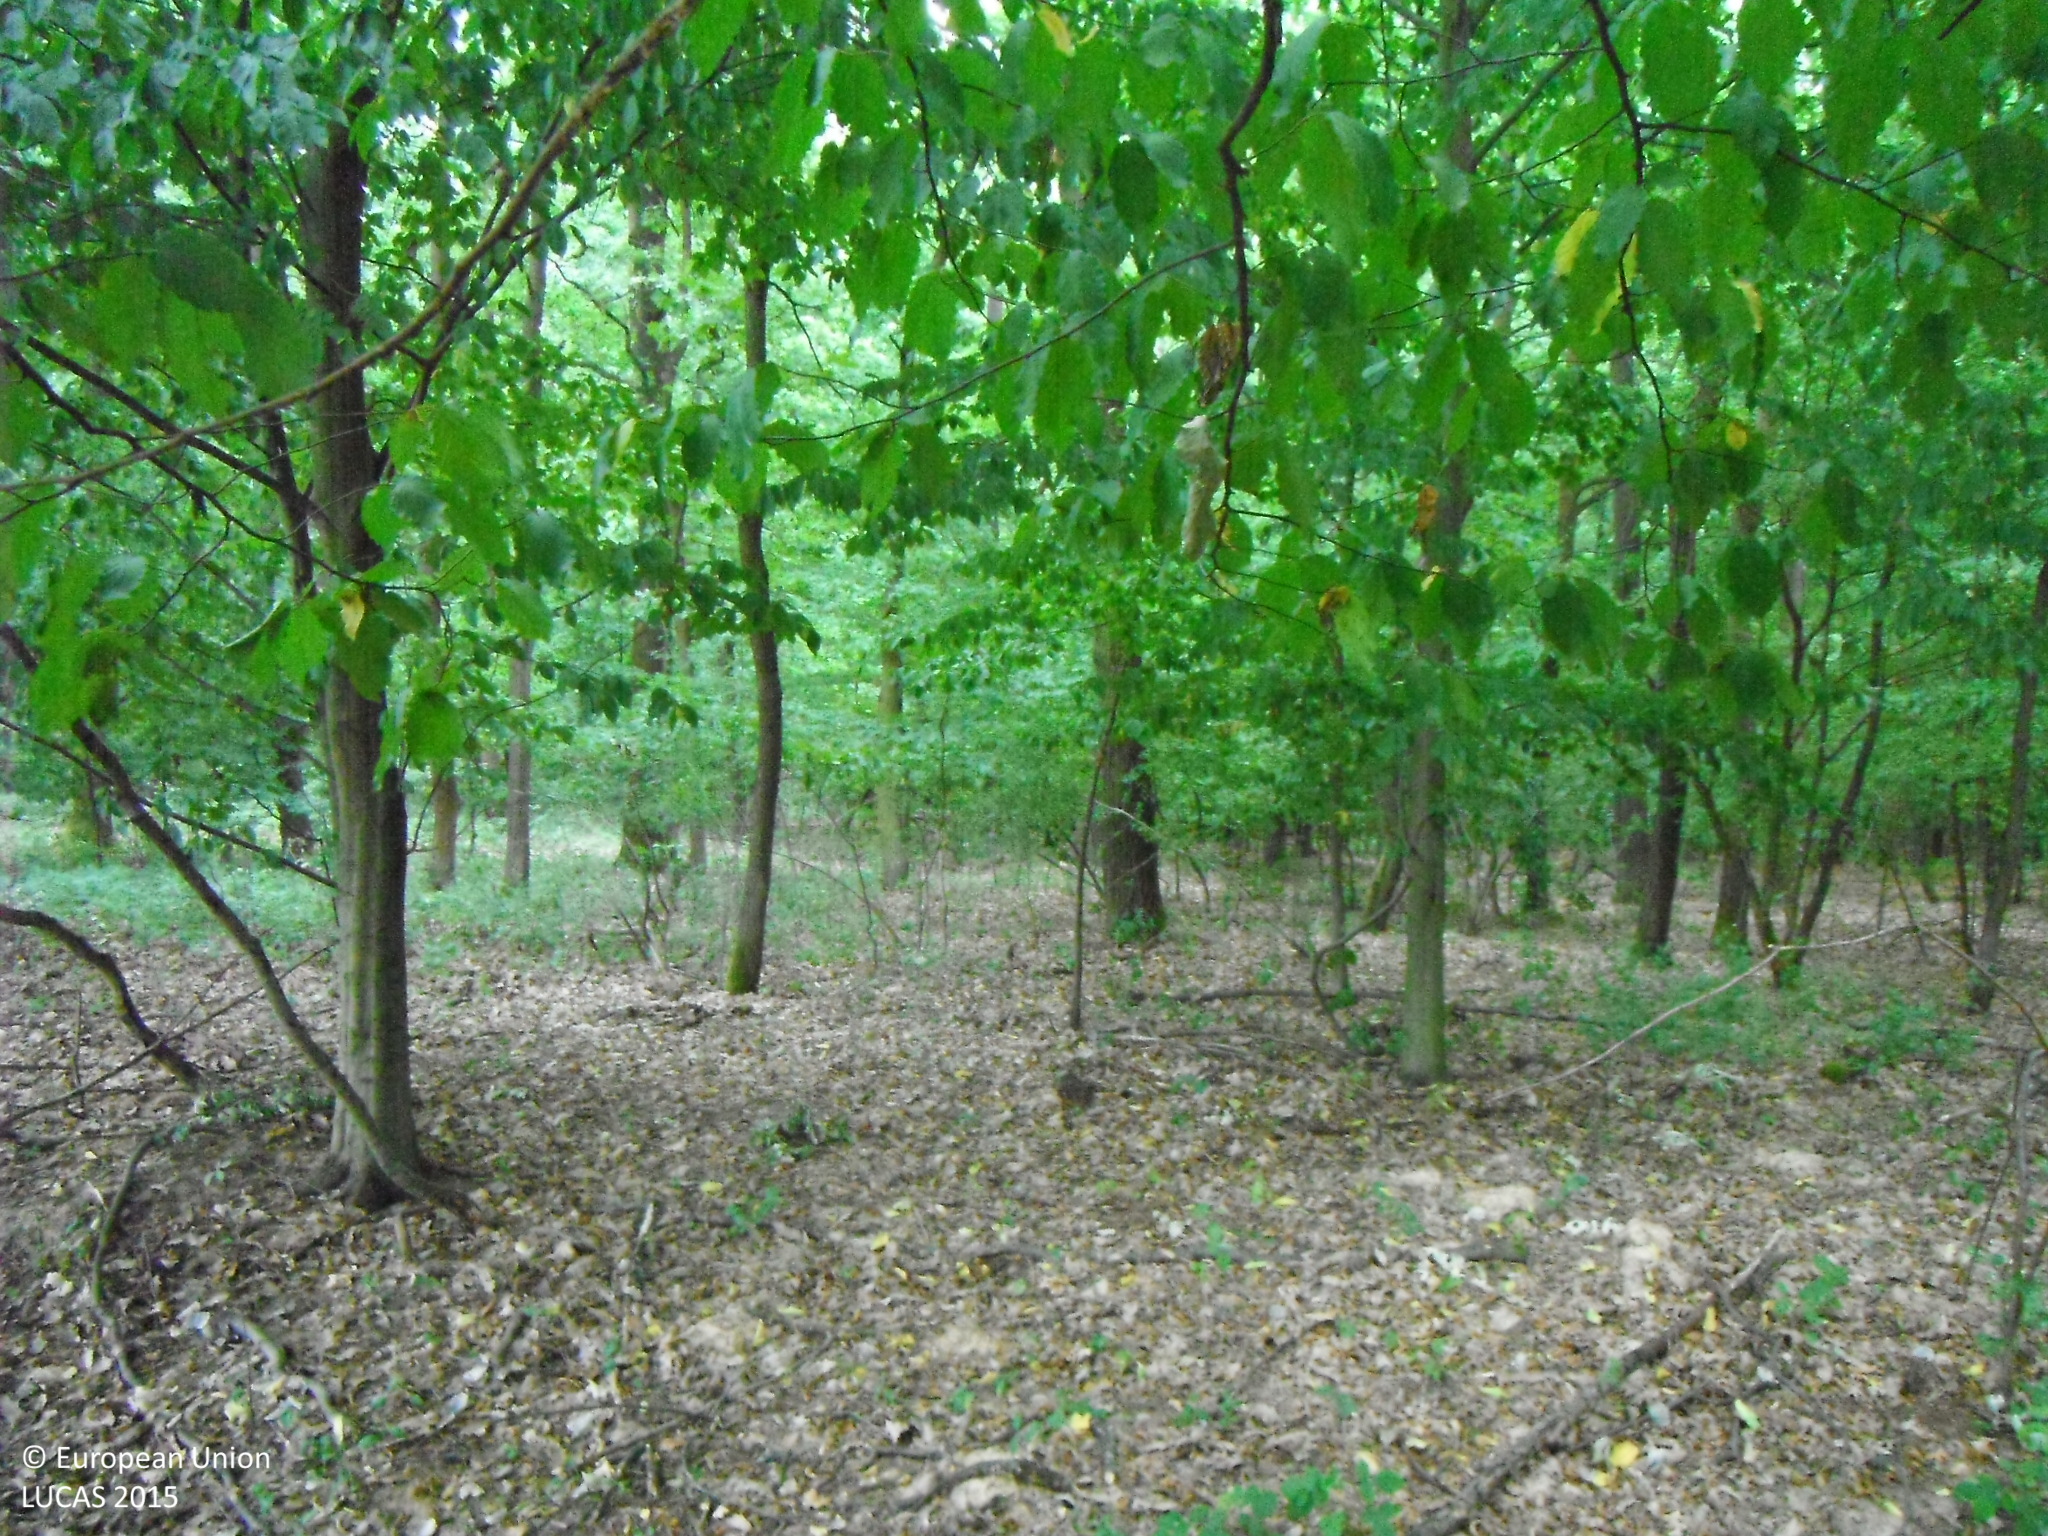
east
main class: Woodland
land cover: Broadleaved woodland
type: mesophytic deciduous forest
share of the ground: > 75 %
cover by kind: broadleaved forest trees 100 %
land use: Forestry
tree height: > 5 m
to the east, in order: Broadleaved woodland
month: July
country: SK
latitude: 48.3300
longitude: 19.9972
